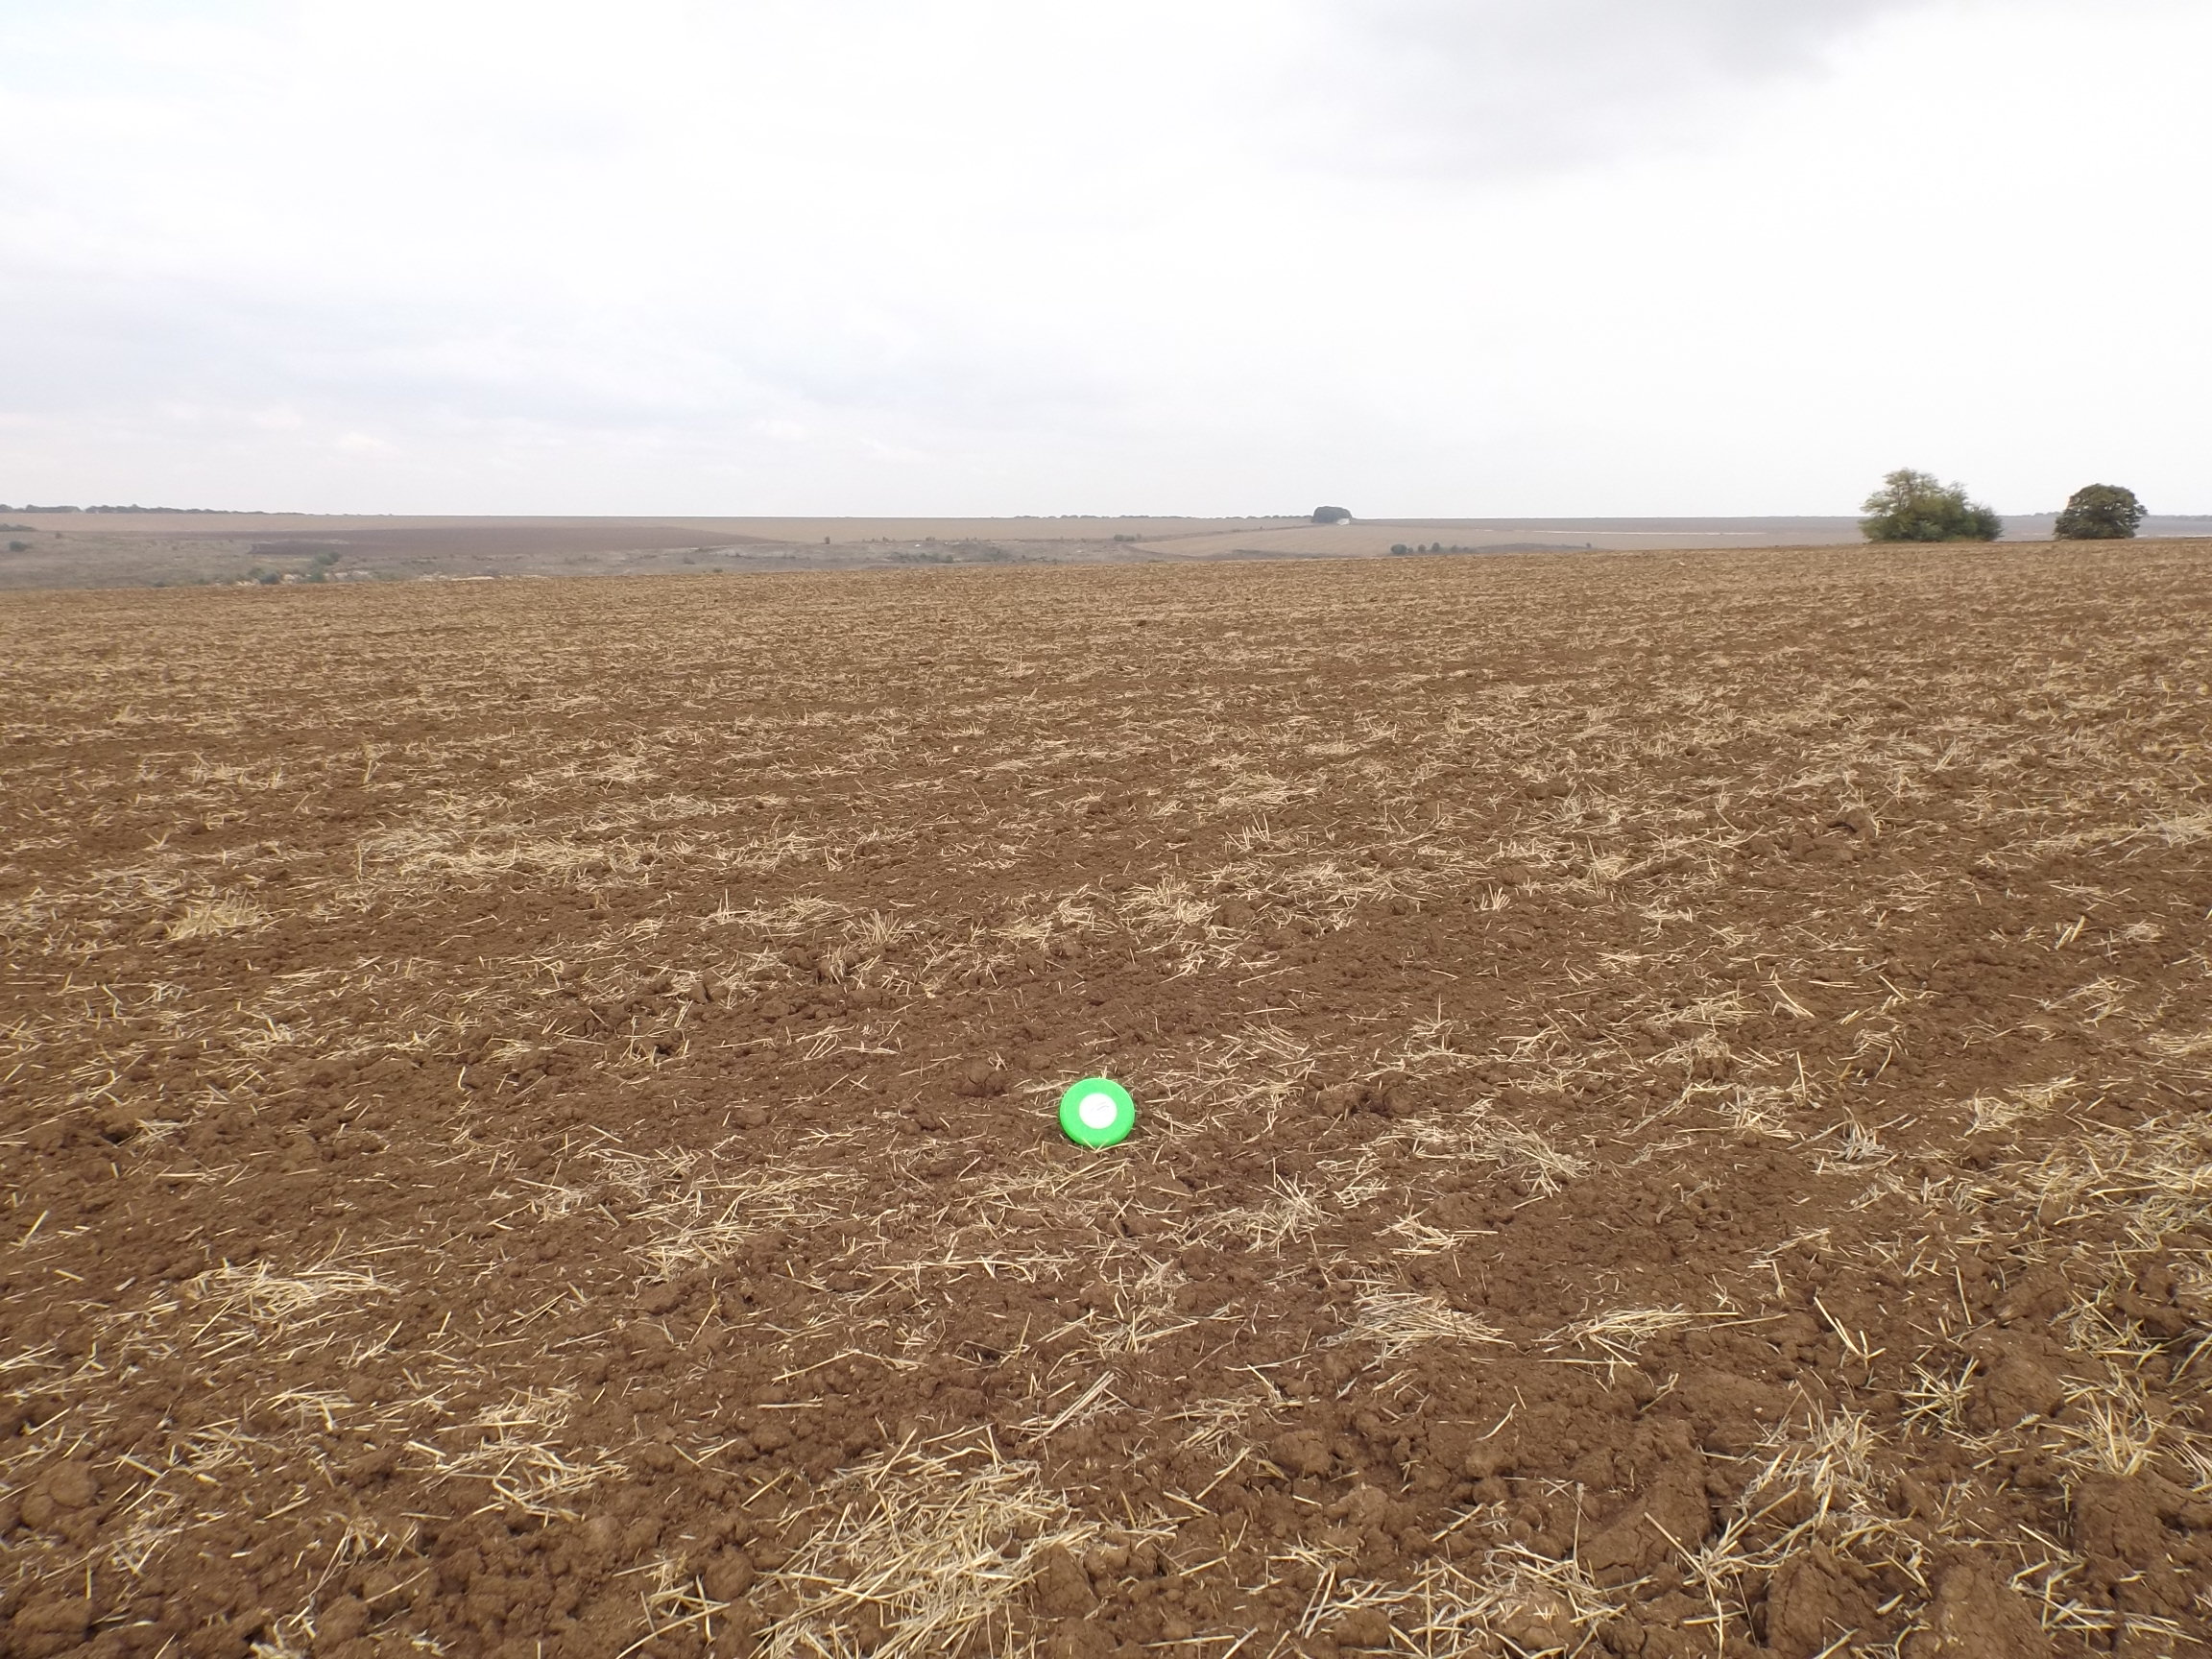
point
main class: Cropland
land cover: Common wheat
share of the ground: < 10 %
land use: Agriculture (excluding fallow land and kitchen gardens)
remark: Harvested field
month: September
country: BG
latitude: 43.4292
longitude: 27.7656
